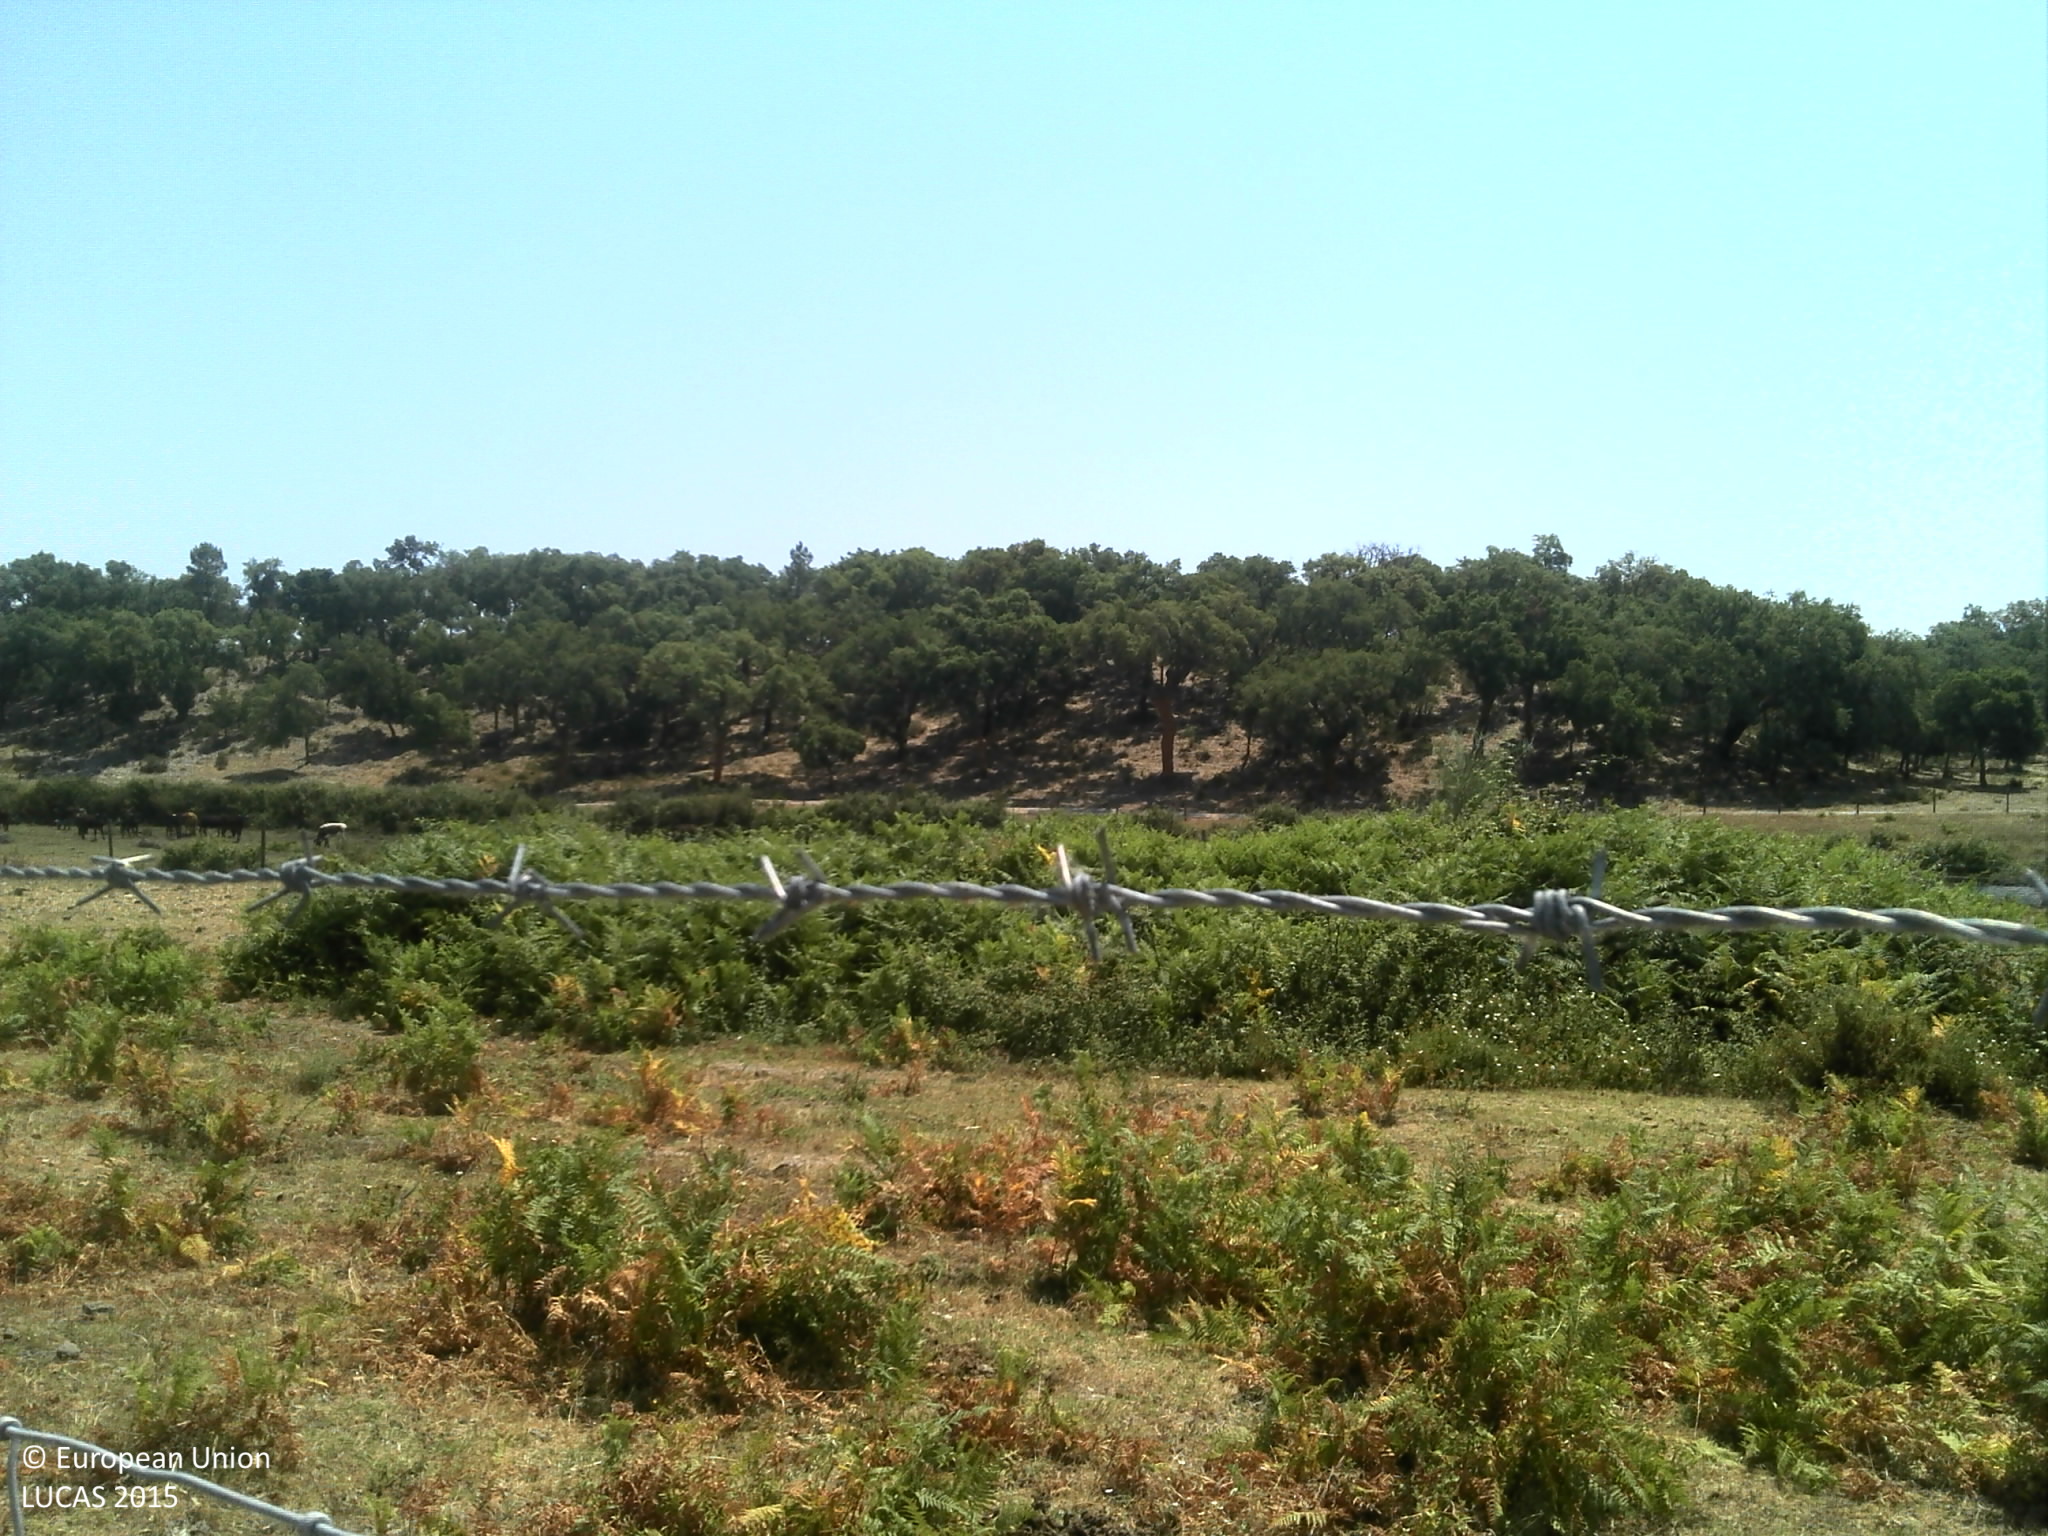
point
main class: Grassland
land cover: Grassland without tree/shrub cover
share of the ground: 50 - 75 %
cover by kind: herbaceous plants 75 %, unconsolidated bare surface 25 %
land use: Agriculture (excluding fallow land and kitchen gardens)
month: June
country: PT
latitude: 39.3914
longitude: -7.9483
